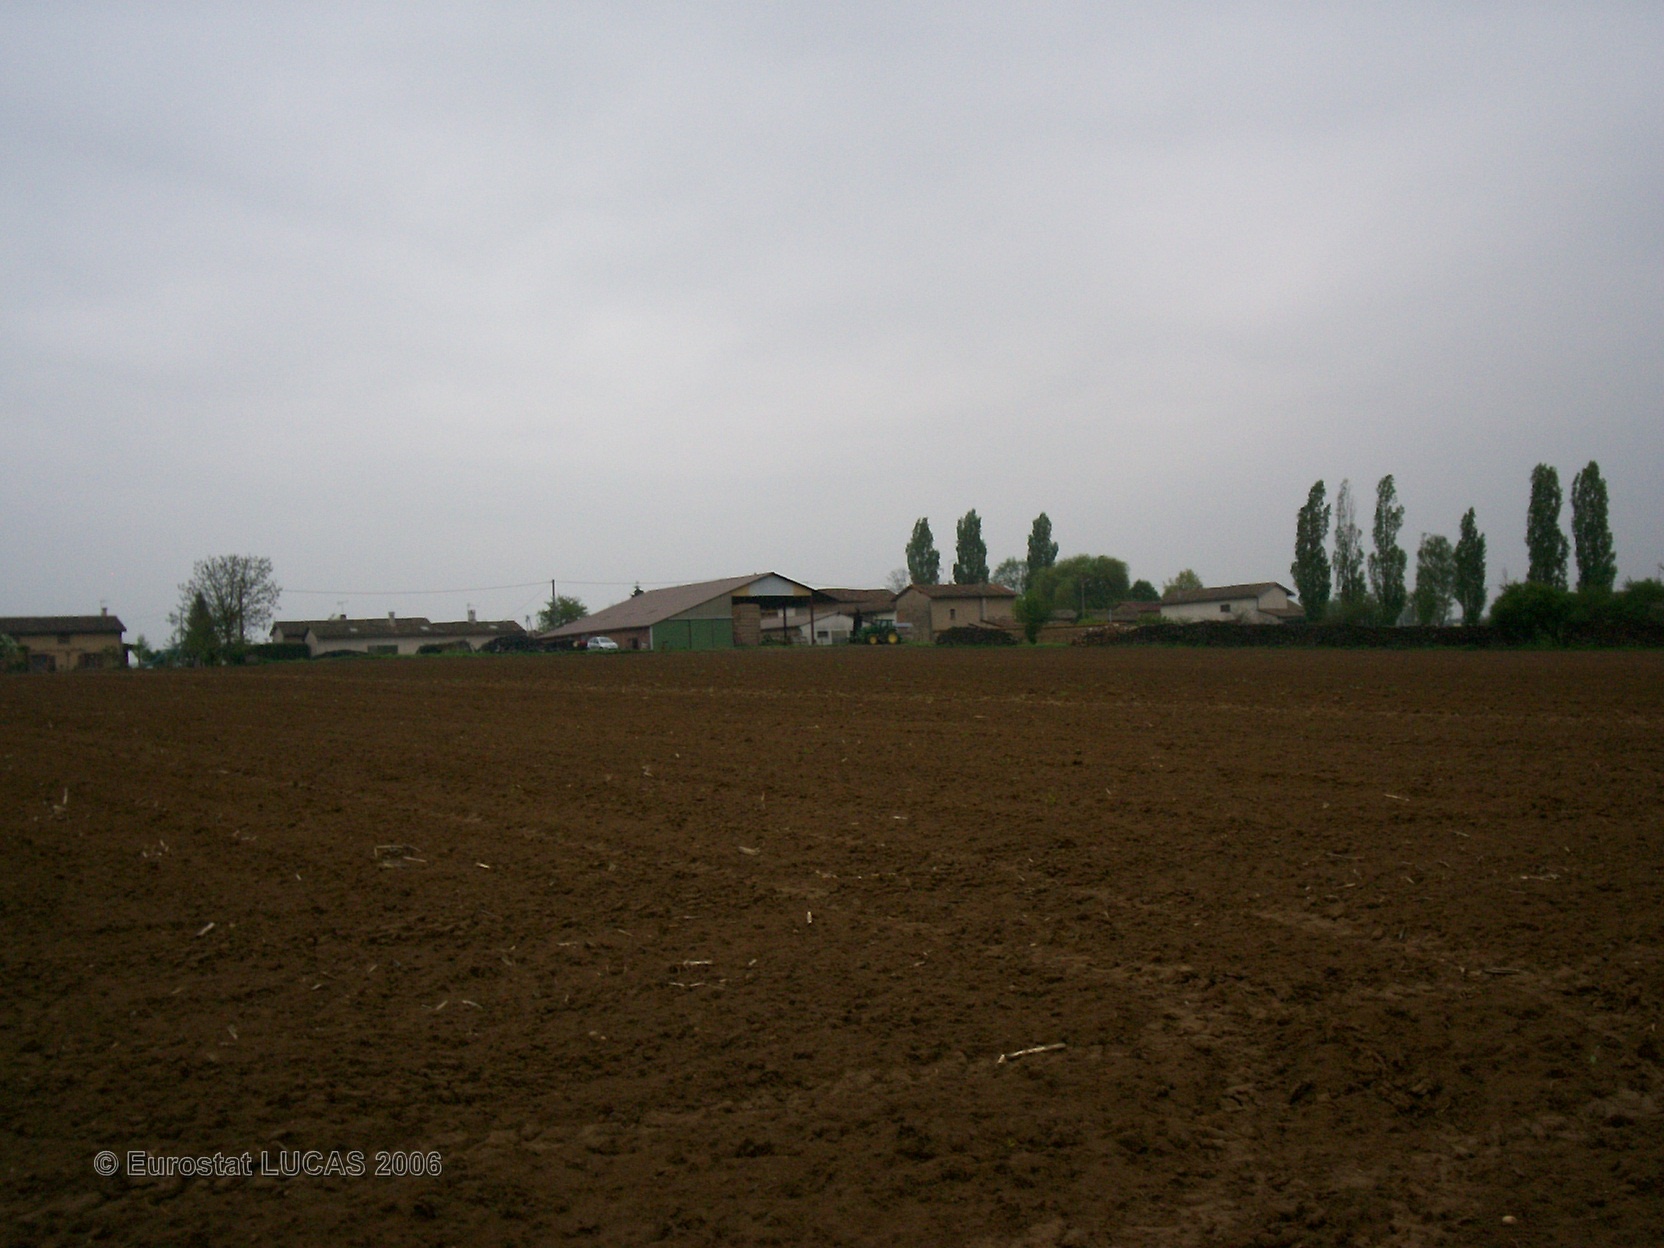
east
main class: Cropland
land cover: Maize
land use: Agriculture (excluding fallow land and kitchen gardens)
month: June
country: FR
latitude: 46.0428
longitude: 4.7692
